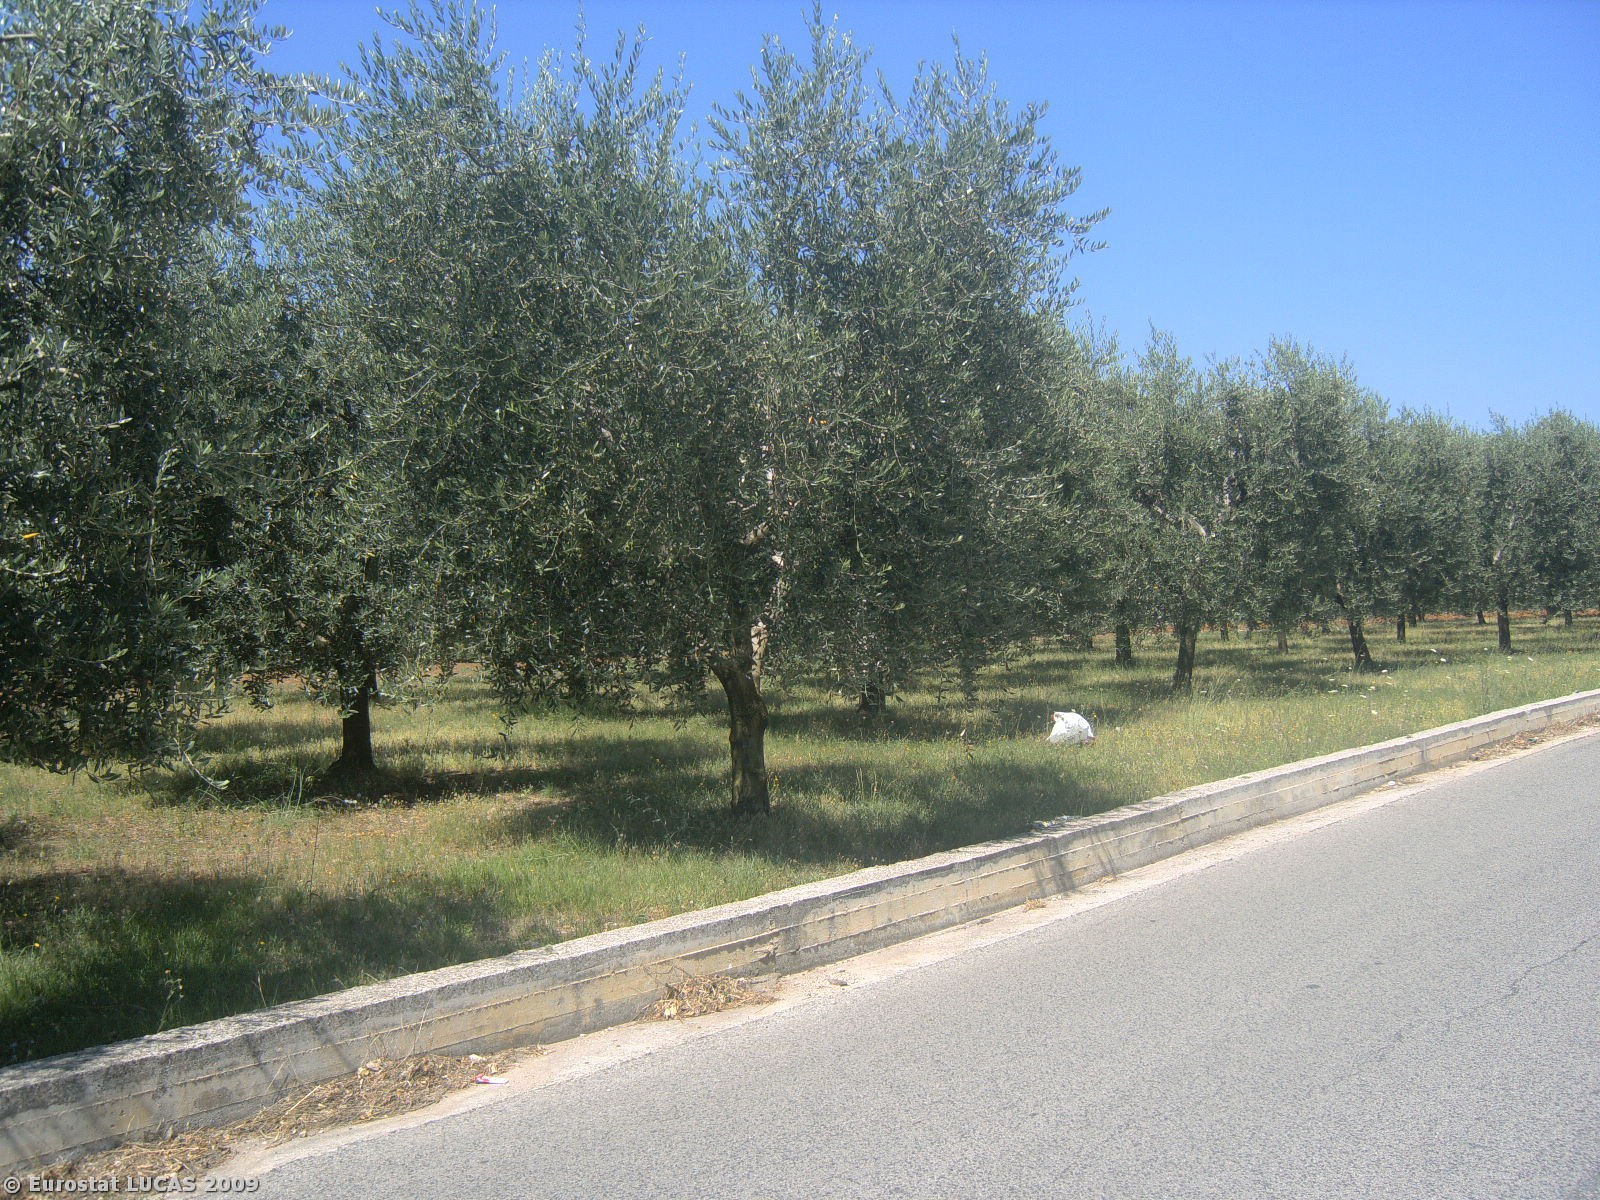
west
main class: Grassland
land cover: Grassland with sparse tree/shrub cover
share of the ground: 25 - 50 %
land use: Residential
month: July
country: IT
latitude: 41.7121
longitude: 13.3648
